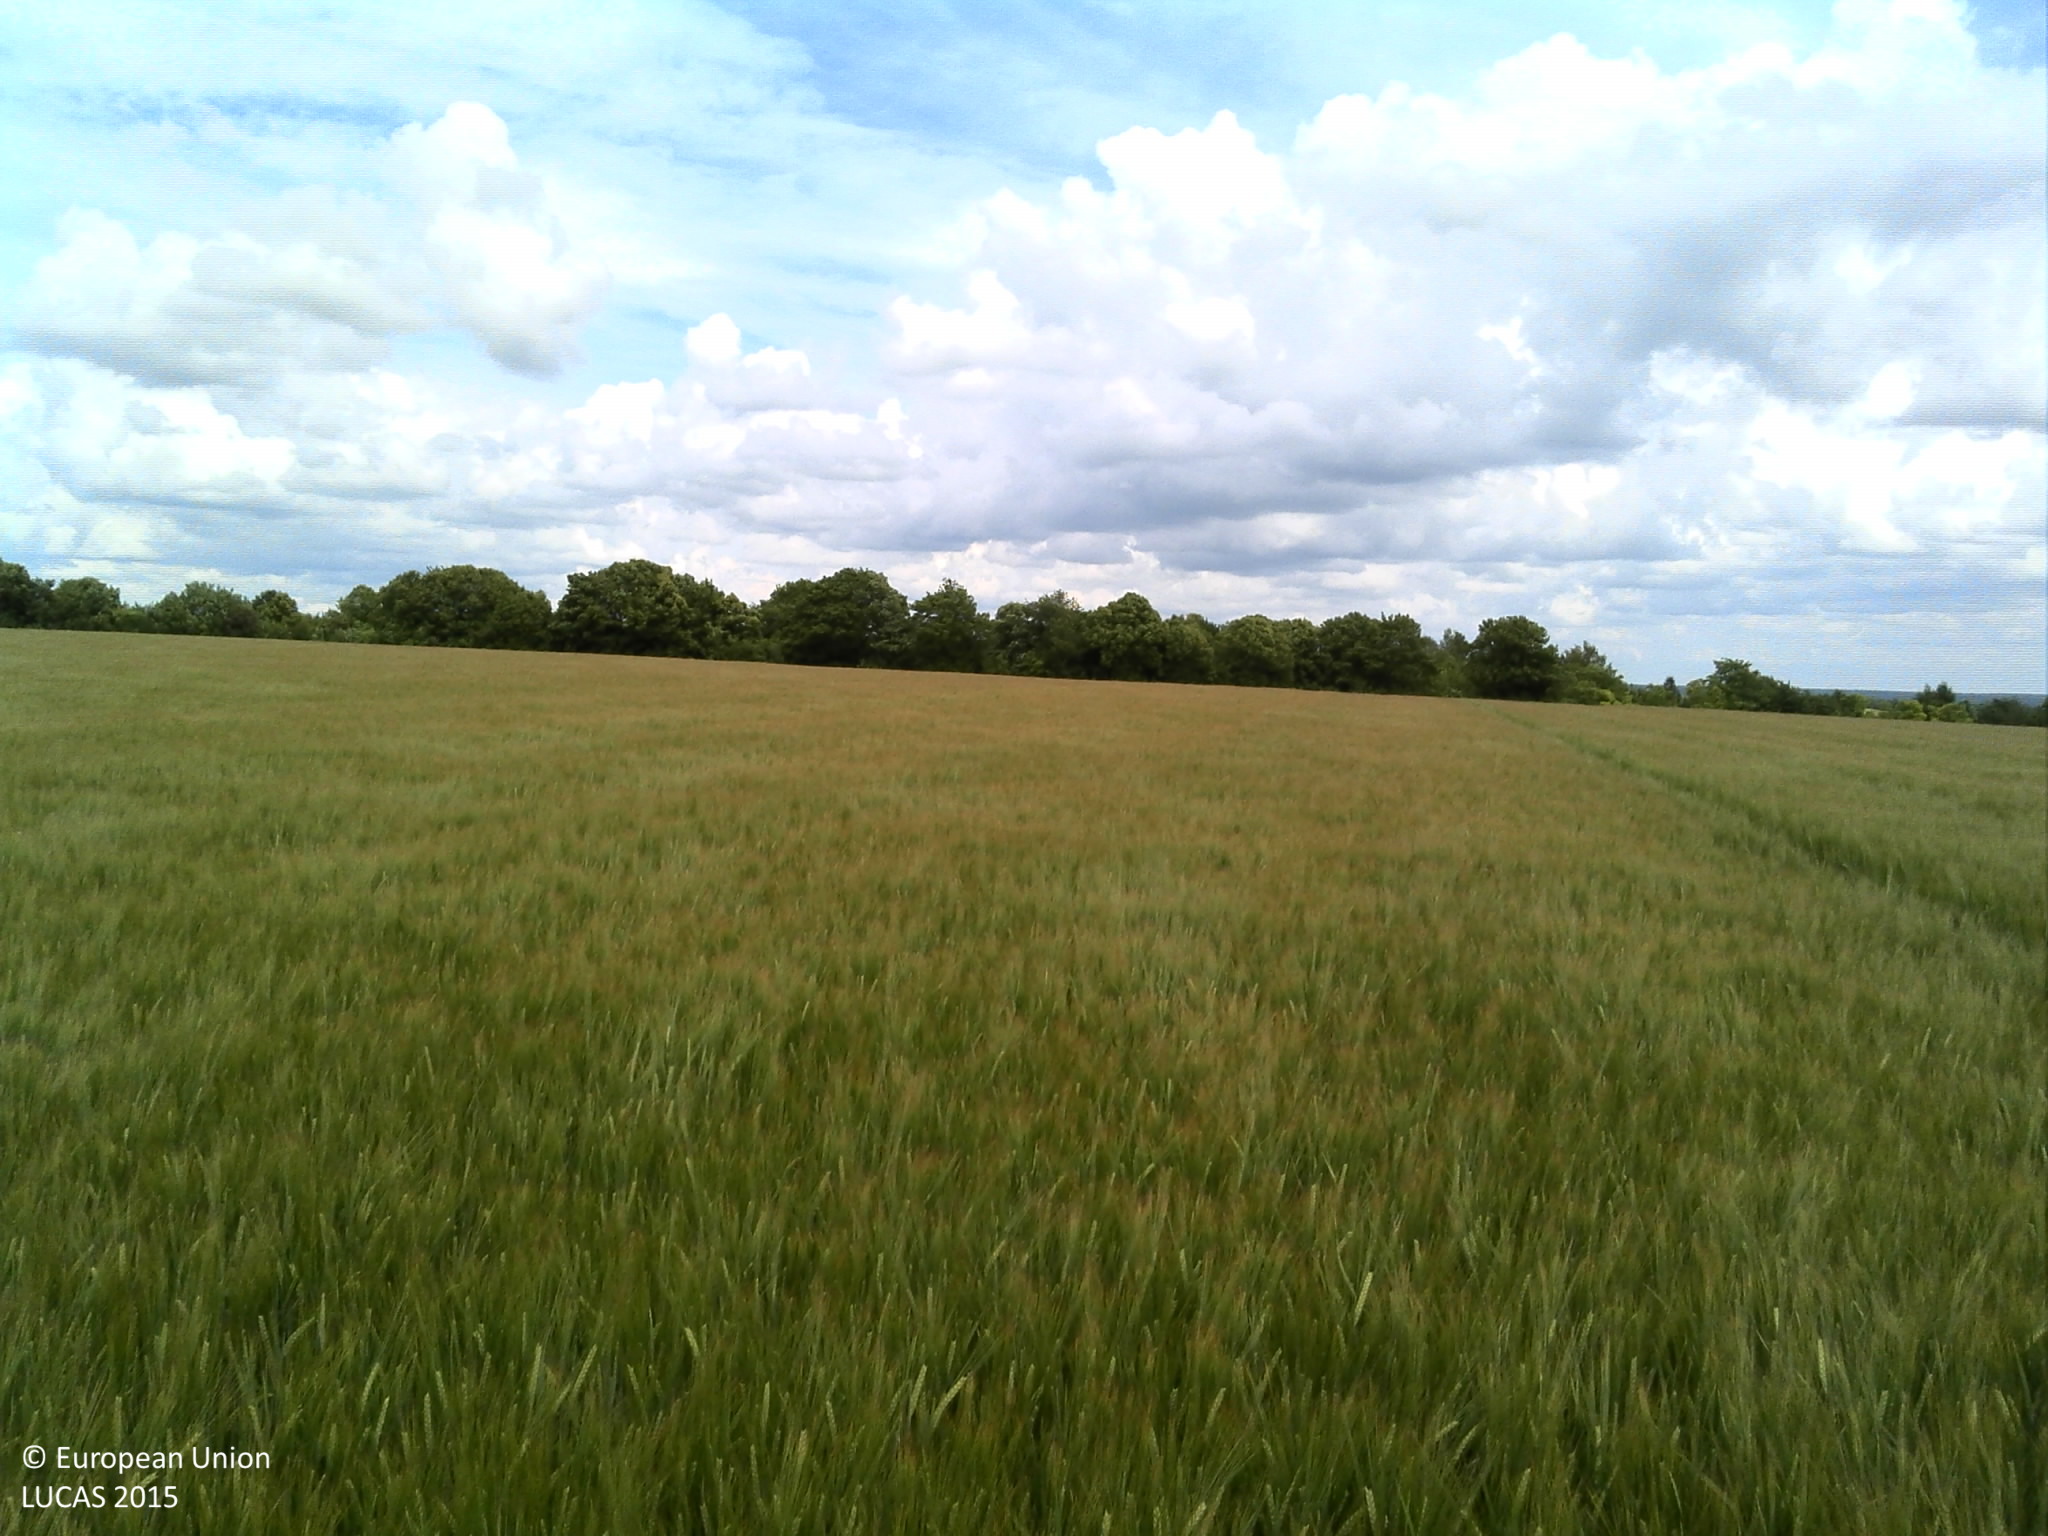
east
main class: Cropland
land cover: Barley
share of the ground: > 75 %
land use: Agriculture (excluding fallow land and kitchen gardens)
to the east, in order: Barley; Common wheat; Tracks; Grass margins; Ditches and canals; Lines of trees; Grassland without tree/shrub cover; Paved roads, cycling and walking lanes
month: June
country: FR
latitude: 48.7019
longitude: 4.1941
